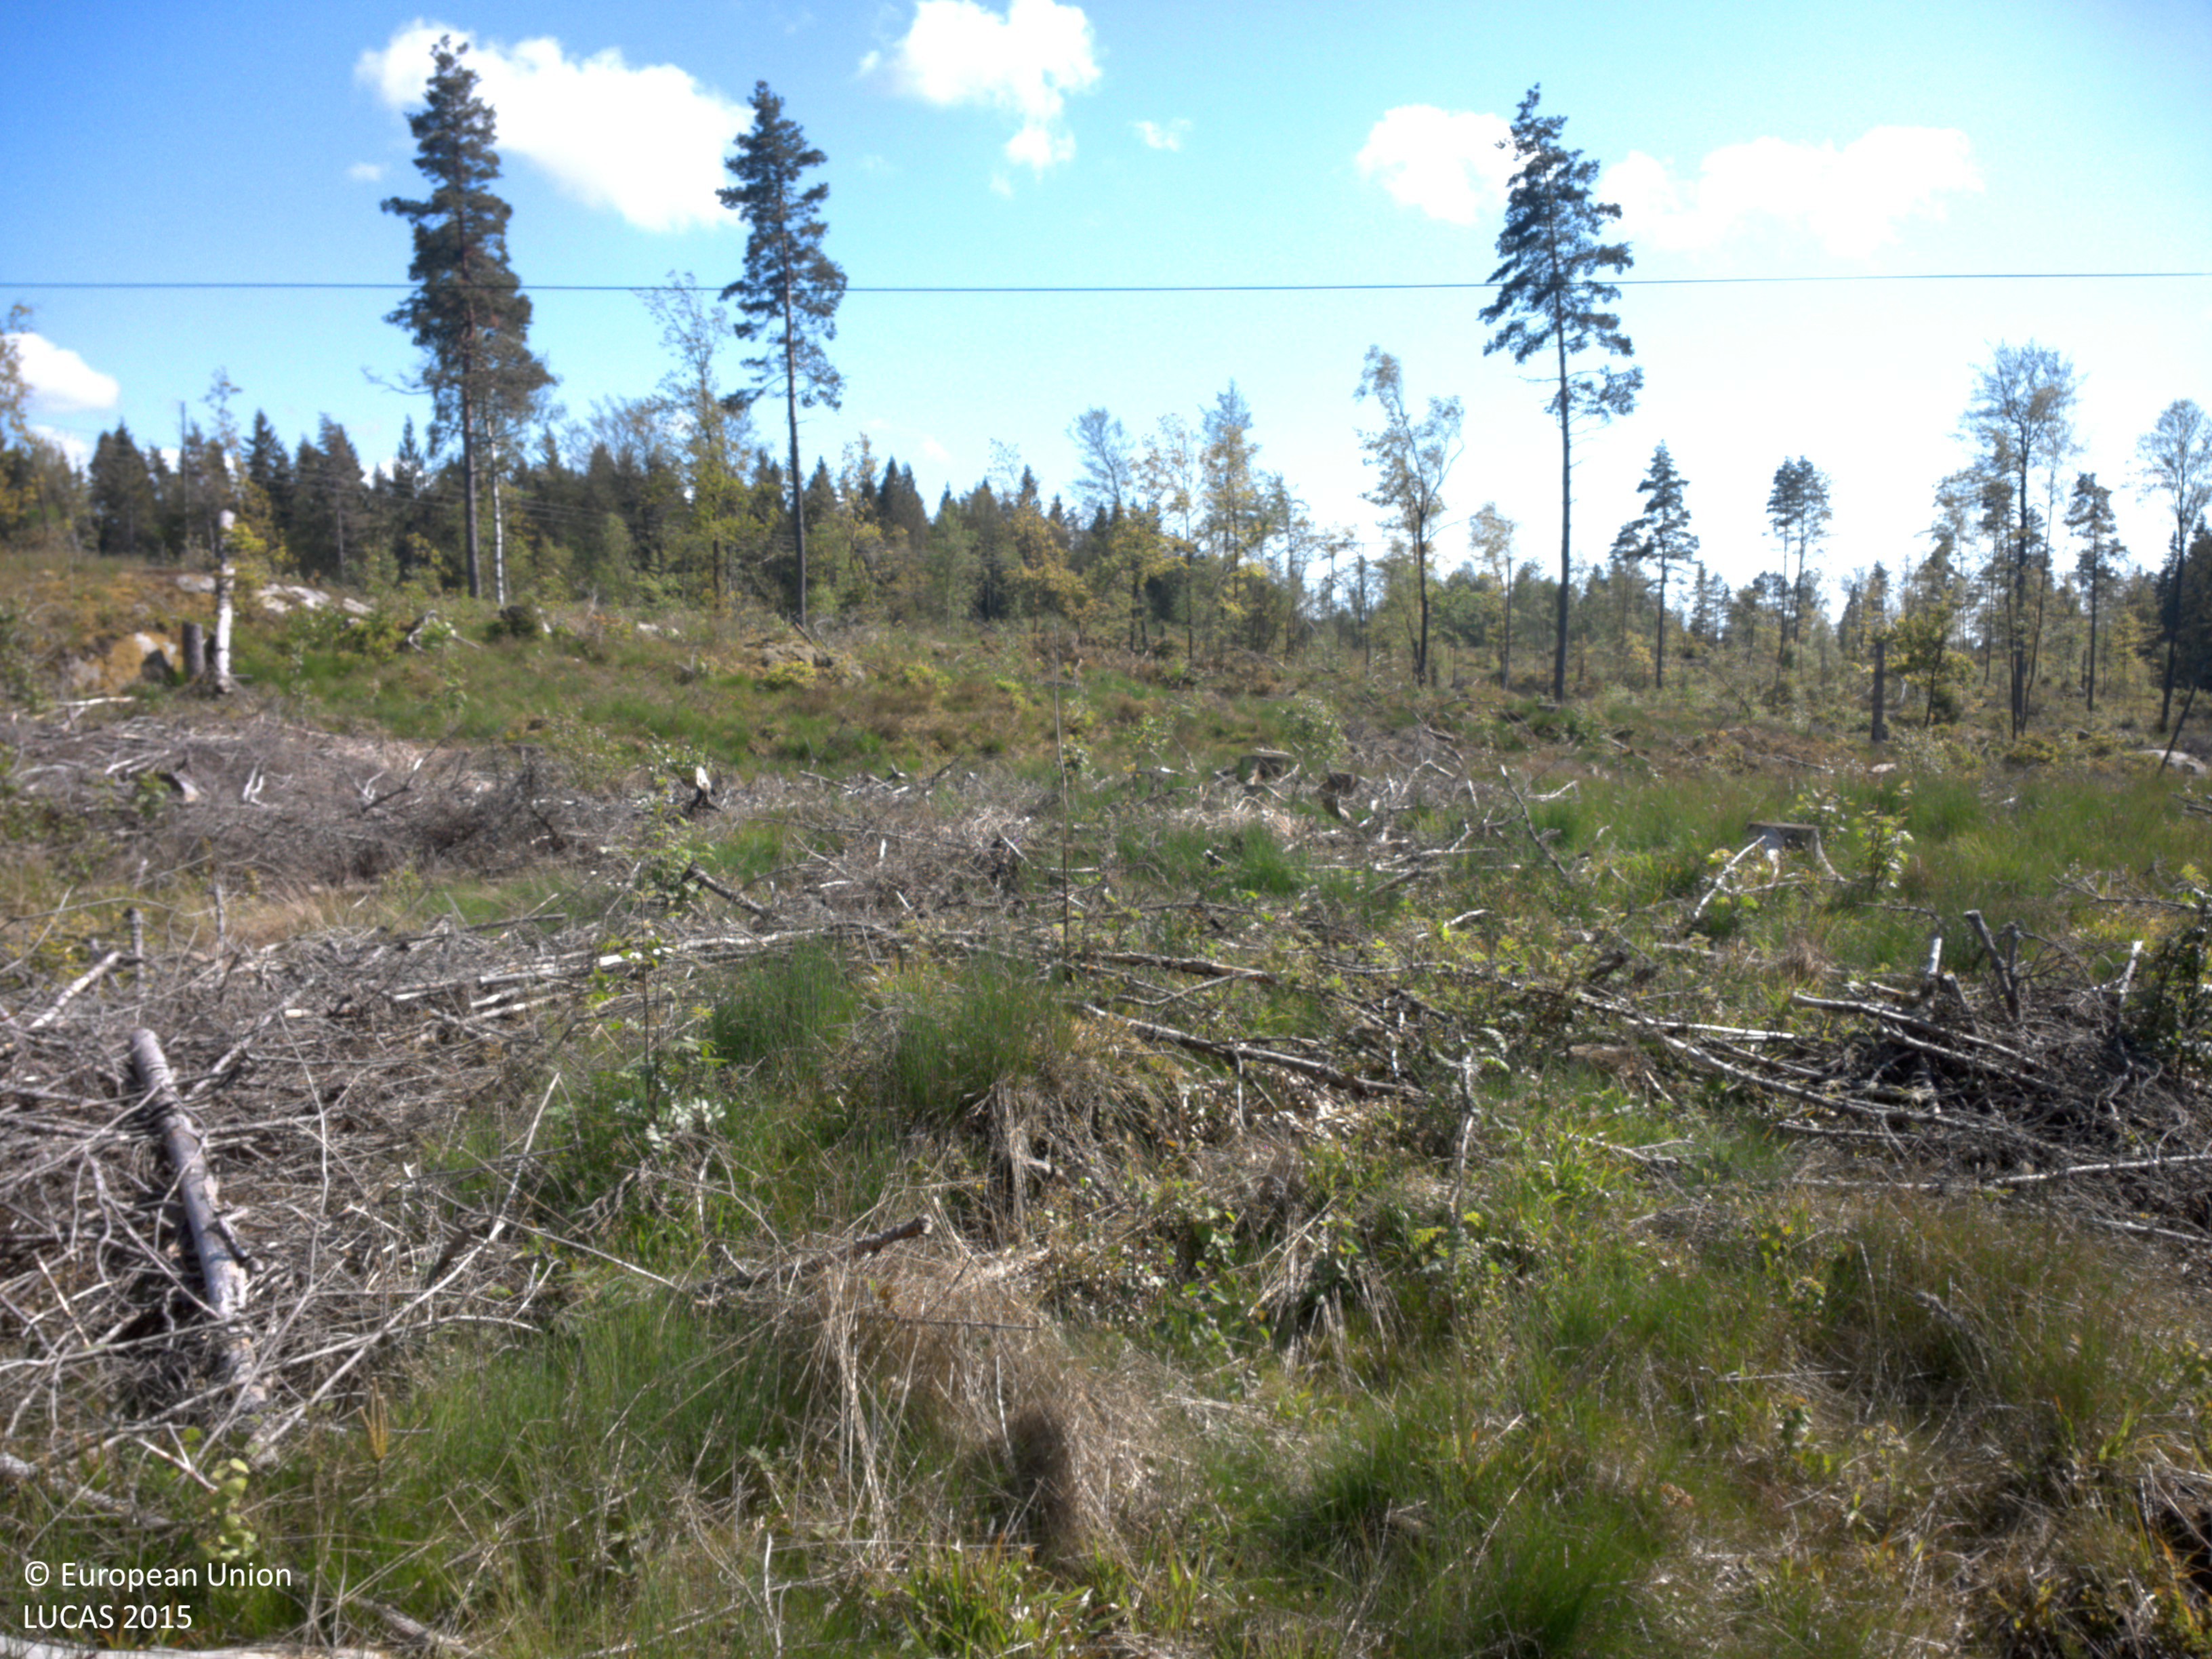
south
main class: Grassland
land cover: Grassland with sparse tree/shrub cover
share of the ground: > 75 %
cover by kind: herbaceous plants 70 %, coniferous forest trees 5 %
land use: Forestry
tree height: > 5 m
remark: Clear cut
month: June
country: SE
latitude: 58.3856
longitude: 11.9288
